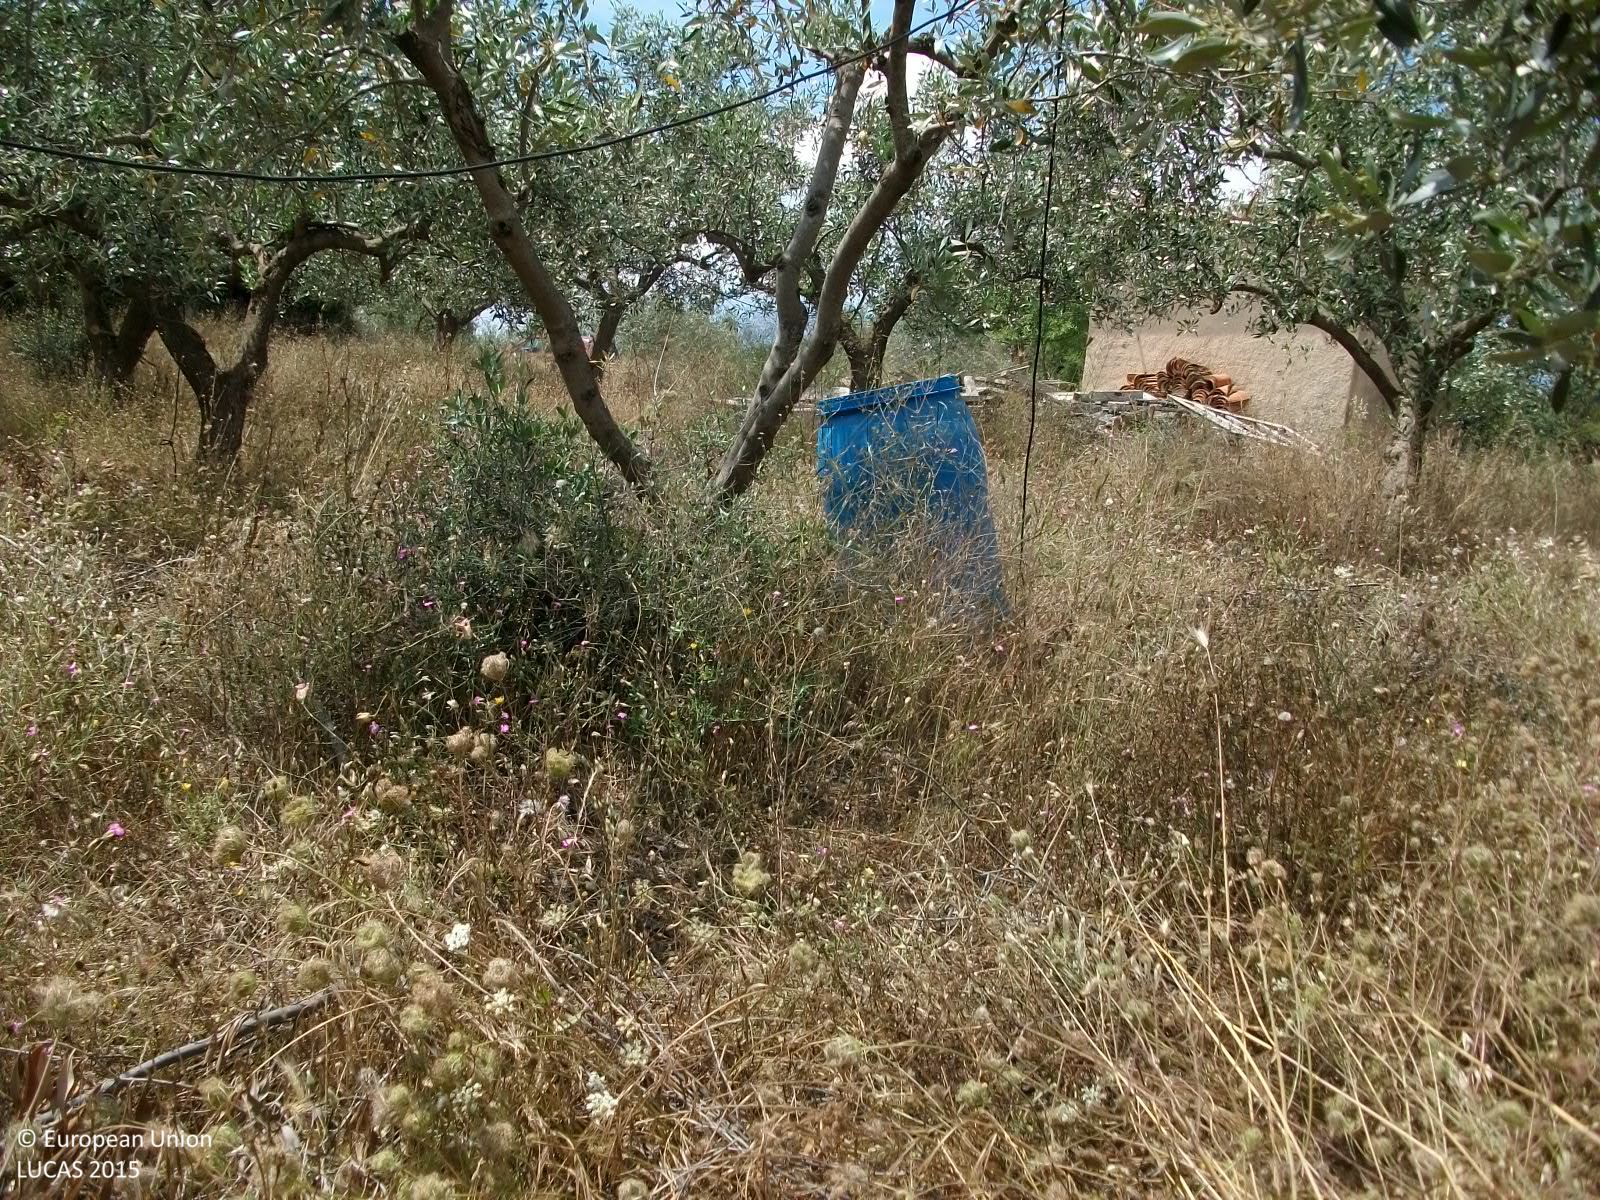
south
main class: Cropland
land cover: Olive groves
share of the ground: 50 - 75 %
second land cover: Spontaneously vegetated surfaces
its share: > 75 %
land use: Agriculture (excluding fallow land and kitchen gardens)
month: June
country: GR
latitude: 37.1647
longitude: 22.4462
